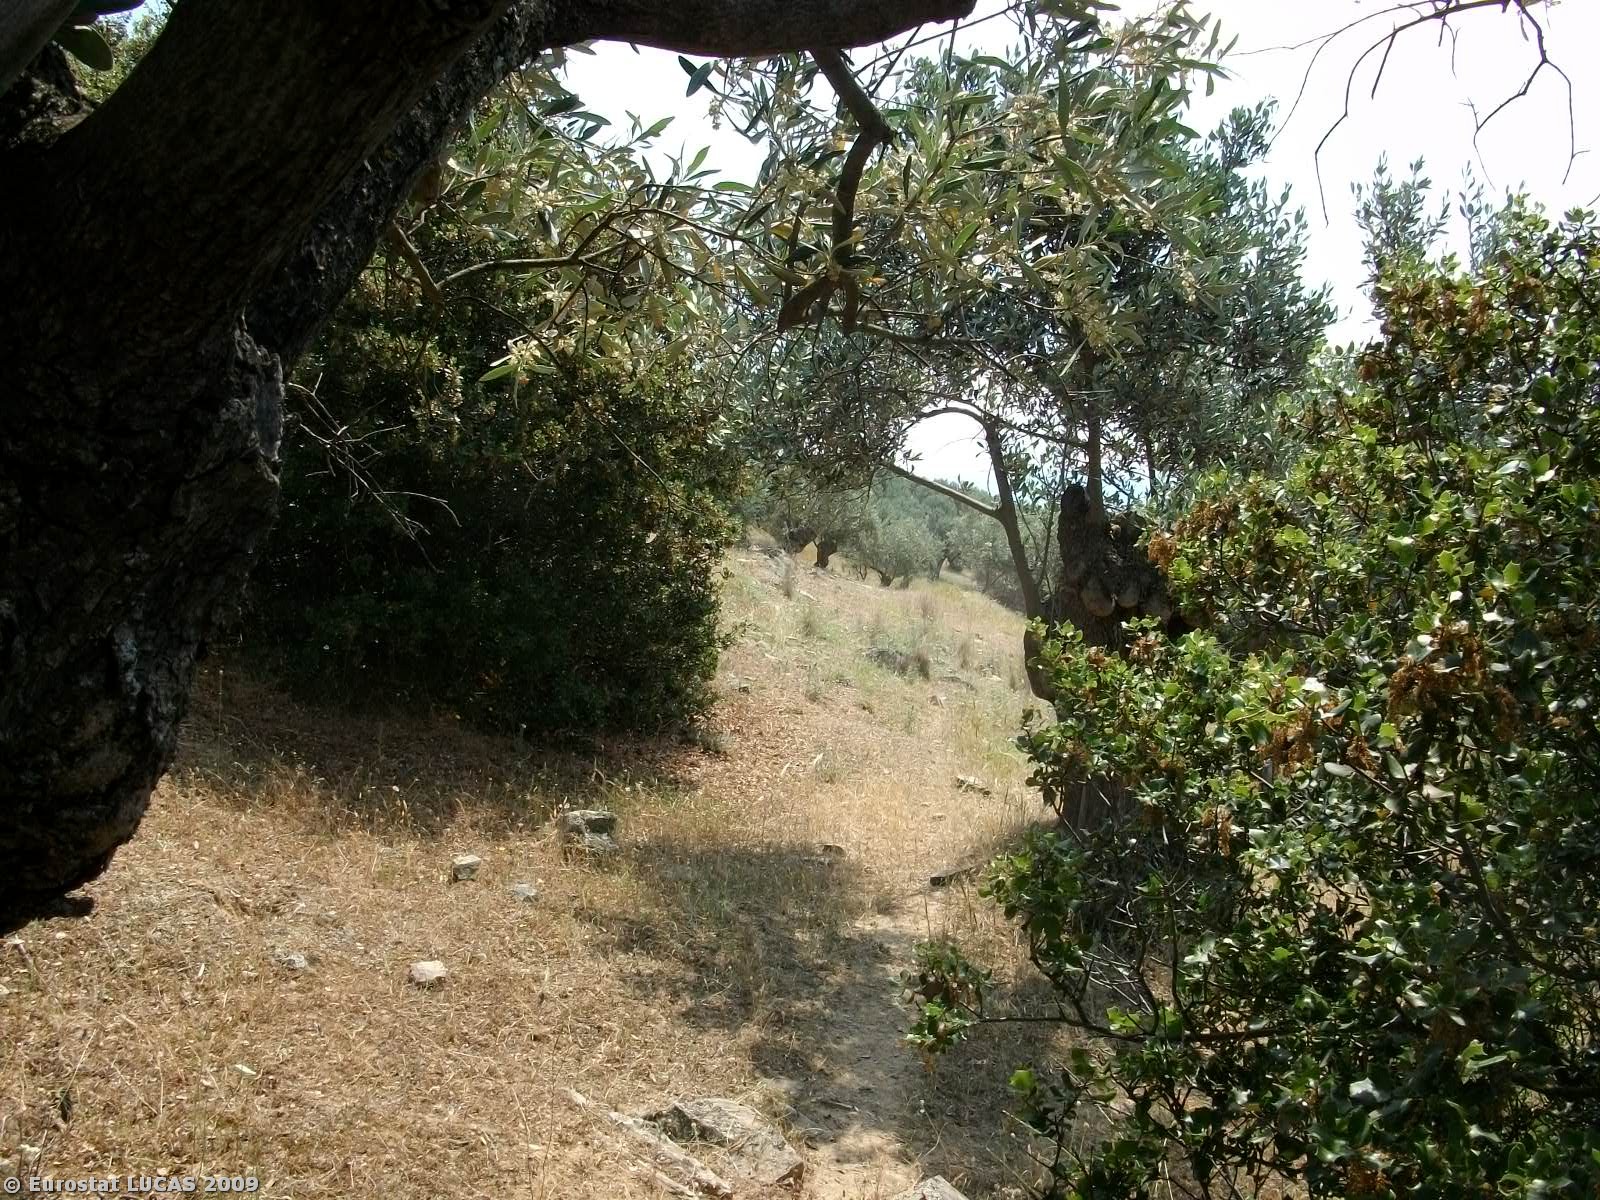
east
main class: Cropland
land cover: Olive groves
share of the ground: 25 - 50 %
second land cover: Grassland with sparse tree/shrub cover
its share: 50 - 75 %
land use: Agriculture (excluding fallow land and kitchen gardens)
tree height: < 5 m
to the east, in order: Olive groves; Grassland with sparse tree/shrub cover; Paved roads, cycling and walking lanes; Olive groves; Grassland with sparse tree/shrub cover; Tracks; Olive groves; Grassland with sparse tree/shrub cover
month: May
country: GR
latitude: 39.8382
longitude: 22.4377
